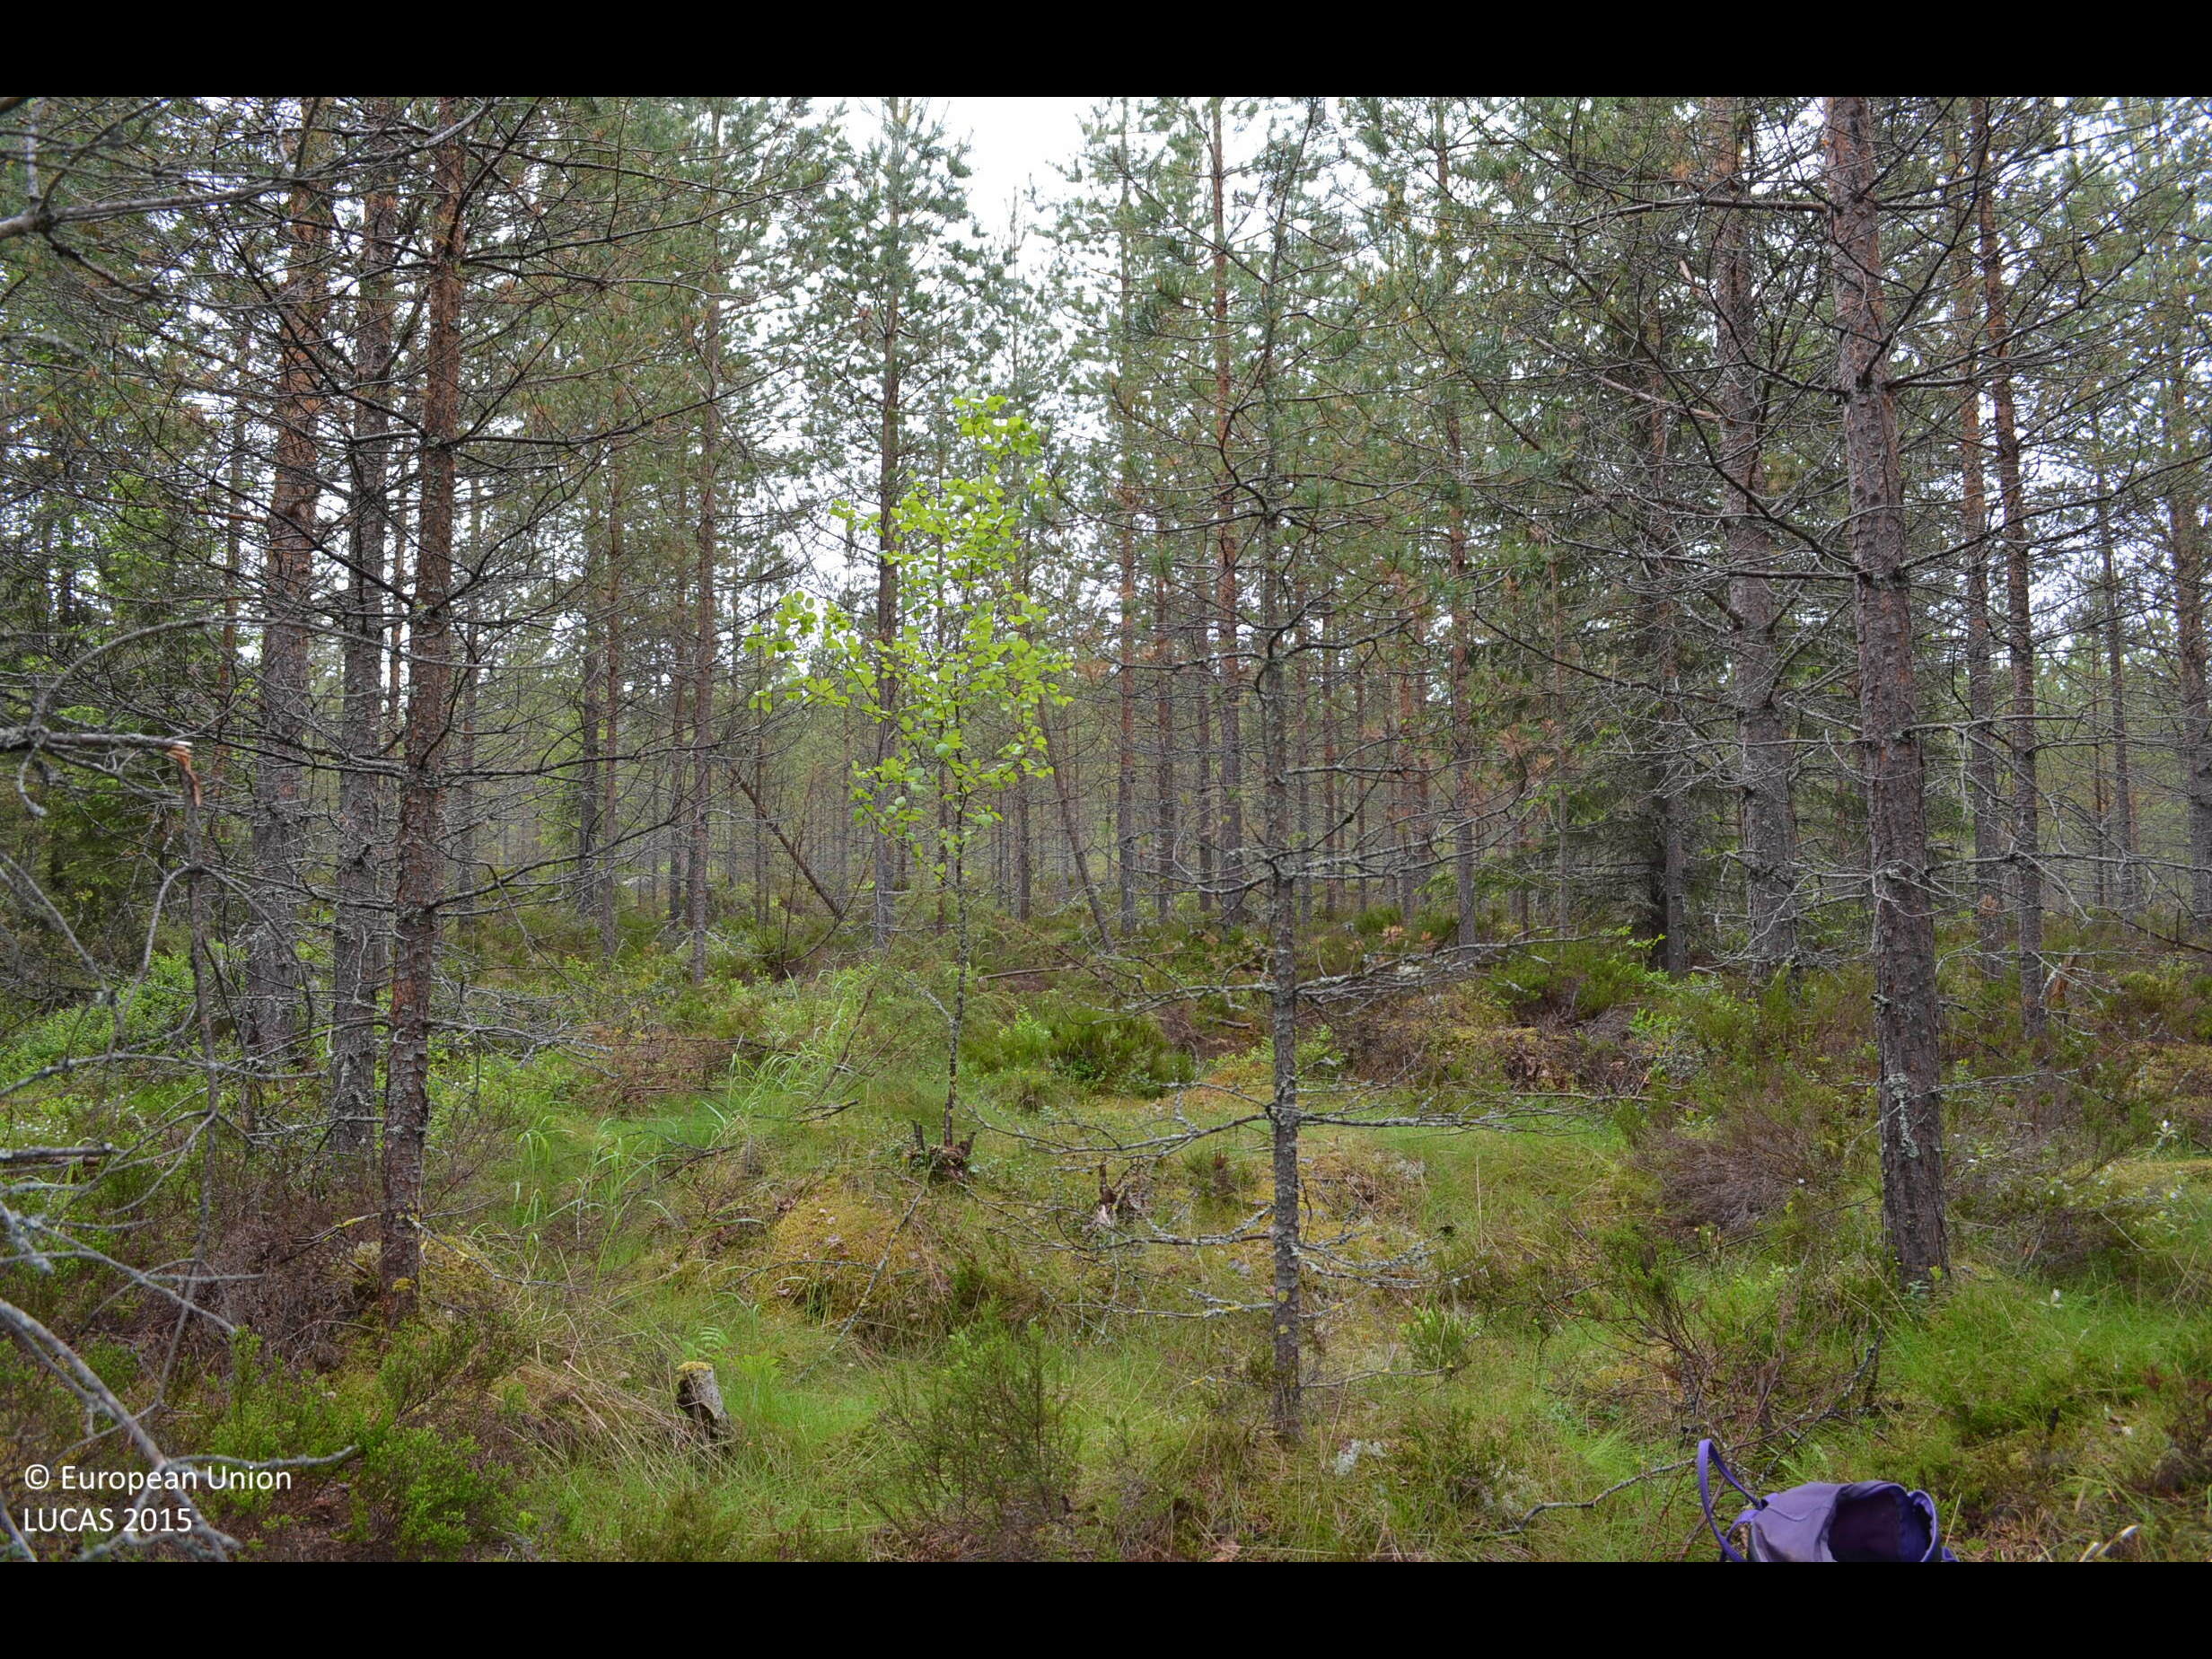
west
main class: Woodland
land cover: Pine dominated coniferous woodland
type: boreal forest
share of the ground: > 75 %
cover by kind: coniferous forest trees 65 %, shrubs 15 %, broadleaved forest trees 10 %, herbaceous plants 5 %, lichens and mosses 5 %
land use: Forestry
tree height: > 5 m
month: June
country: FI
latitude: 61.9269
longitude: 23.5050
